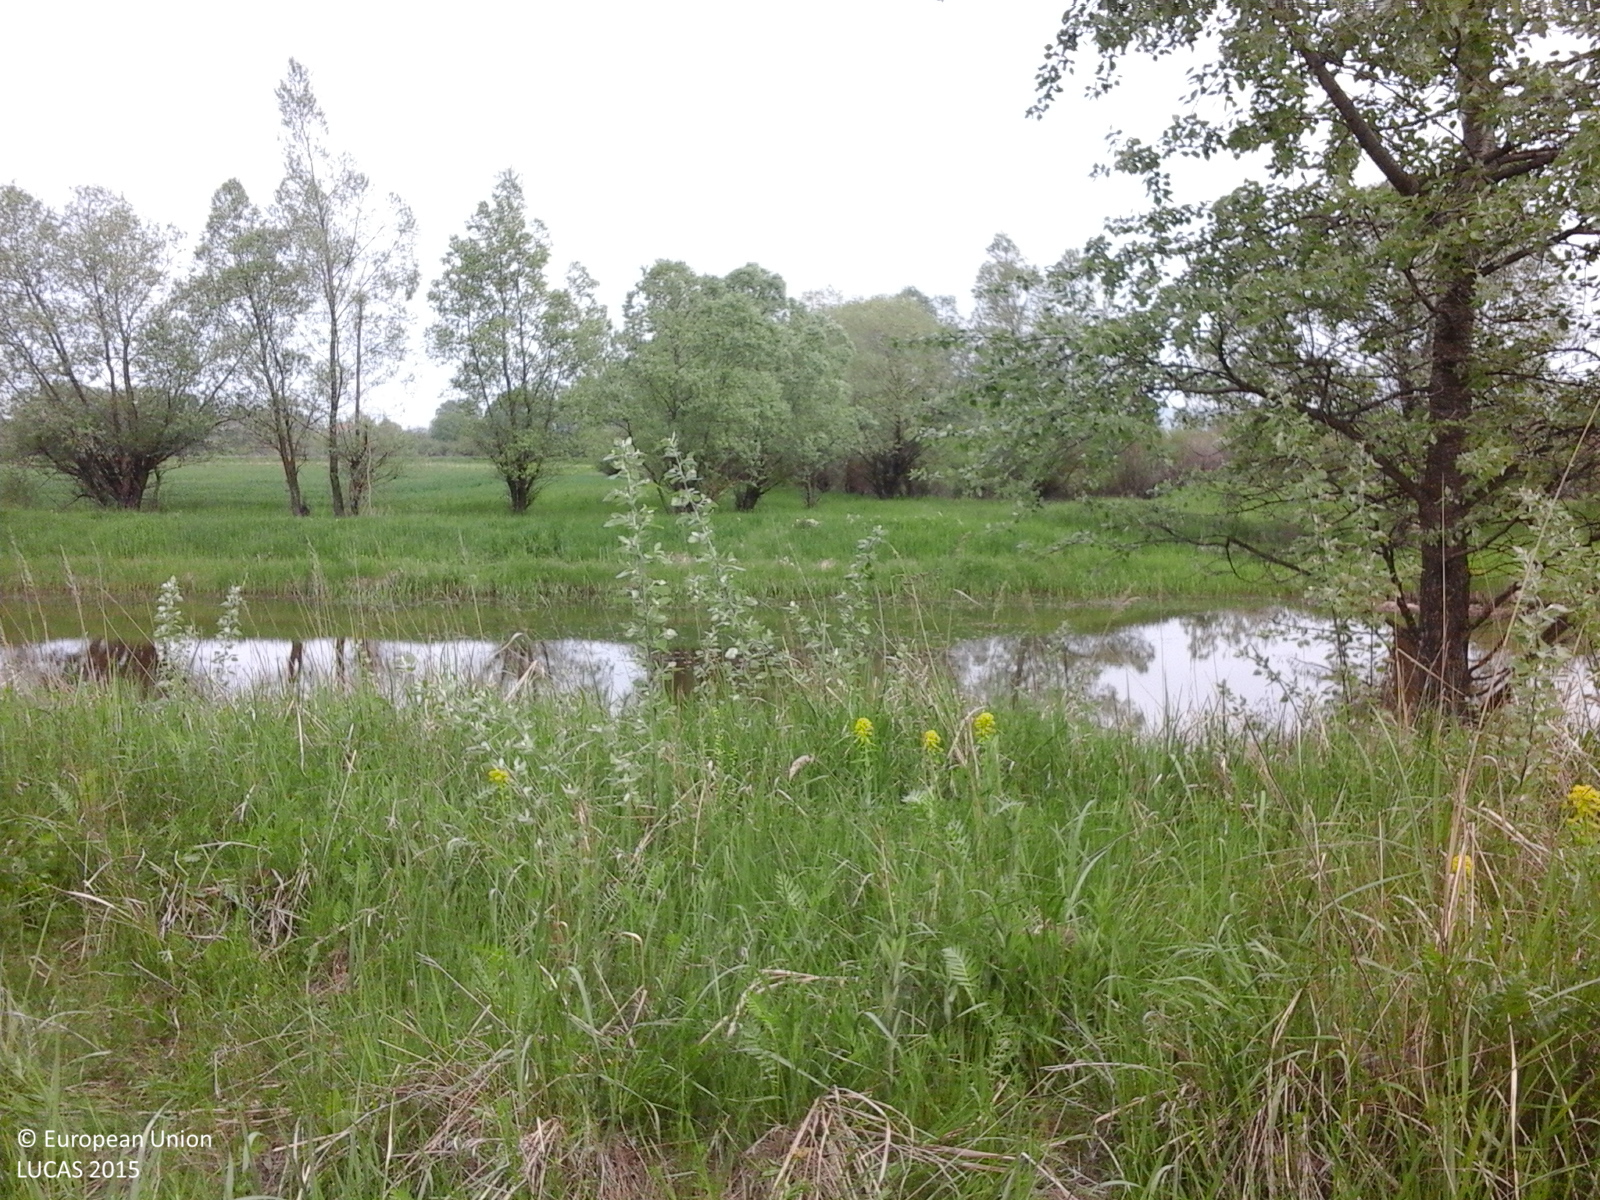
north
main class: Grassland
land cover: Grassland with sparse tree/shrub cover
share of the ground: > 75 %
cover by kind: herbaceous plants 90 %, broadleaved forest trees 5 %, shrubs 5 %
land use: Agriculture (excluding fallow land and kitchen gardens)
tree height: > 5 m
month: May
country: RO
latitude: 45.8160
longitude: 25.8781
